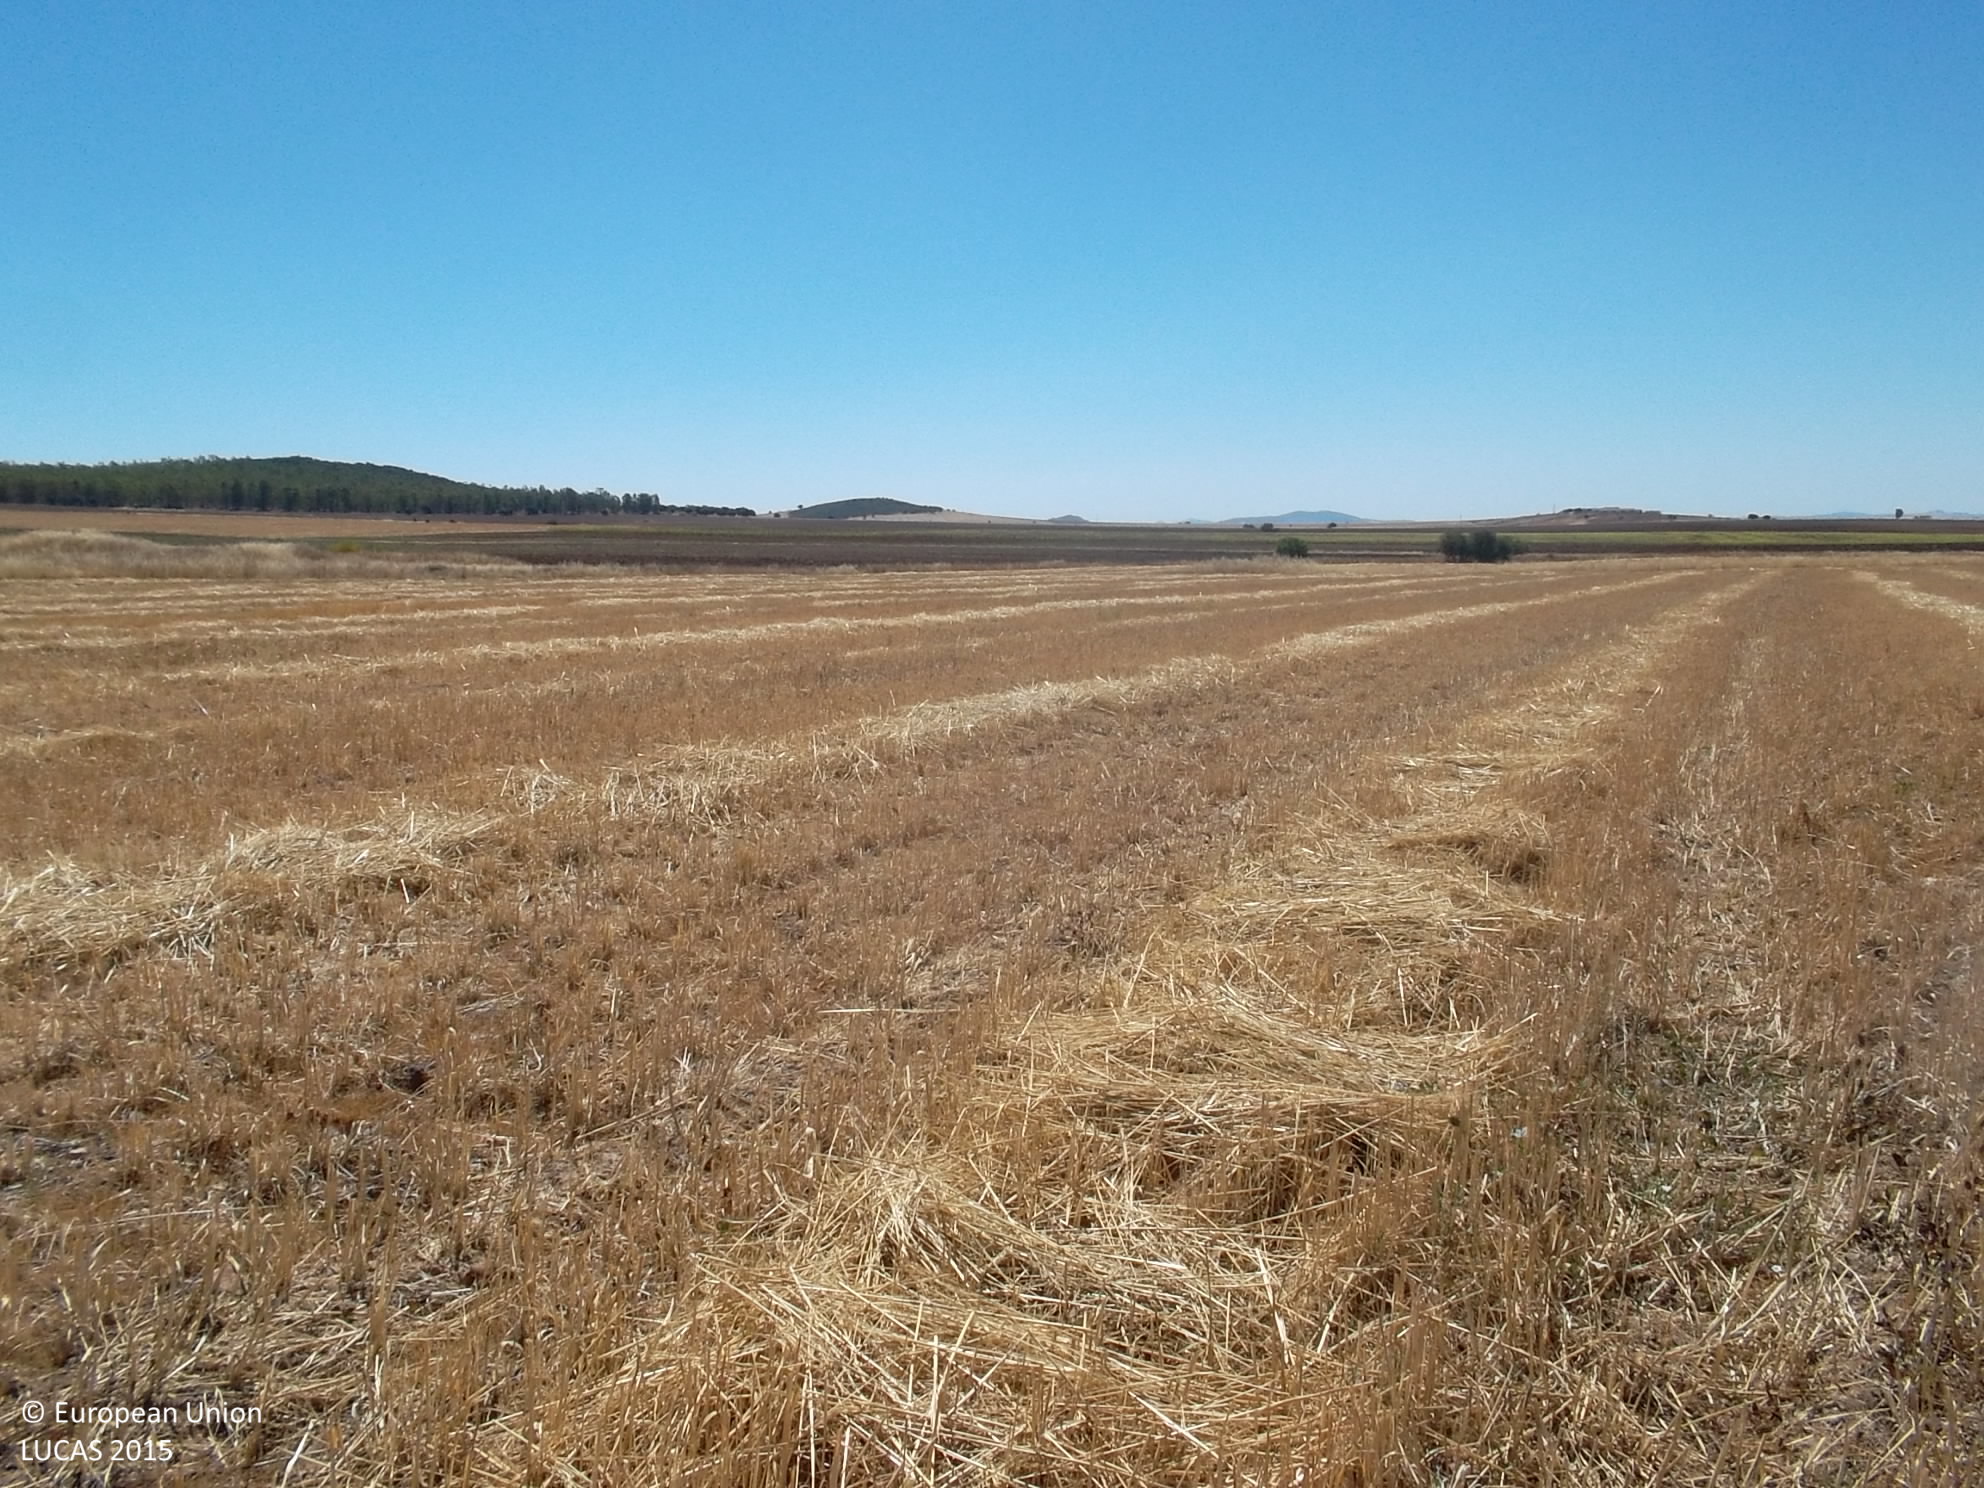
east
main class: Cropland
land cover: Oats
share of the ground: < 10 %
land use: Agriculture (excluding fallow land and kitchen gardens)
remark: Harvested field
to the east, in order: Oats; Grass margins; Oats; Rock outcrops; Grassland without tree/shrub cover; Ponds and wetlands; Grassland without tree/shrub cover; Other bare soil
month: July
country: ES
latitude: 38.4601
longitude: -5.7040
